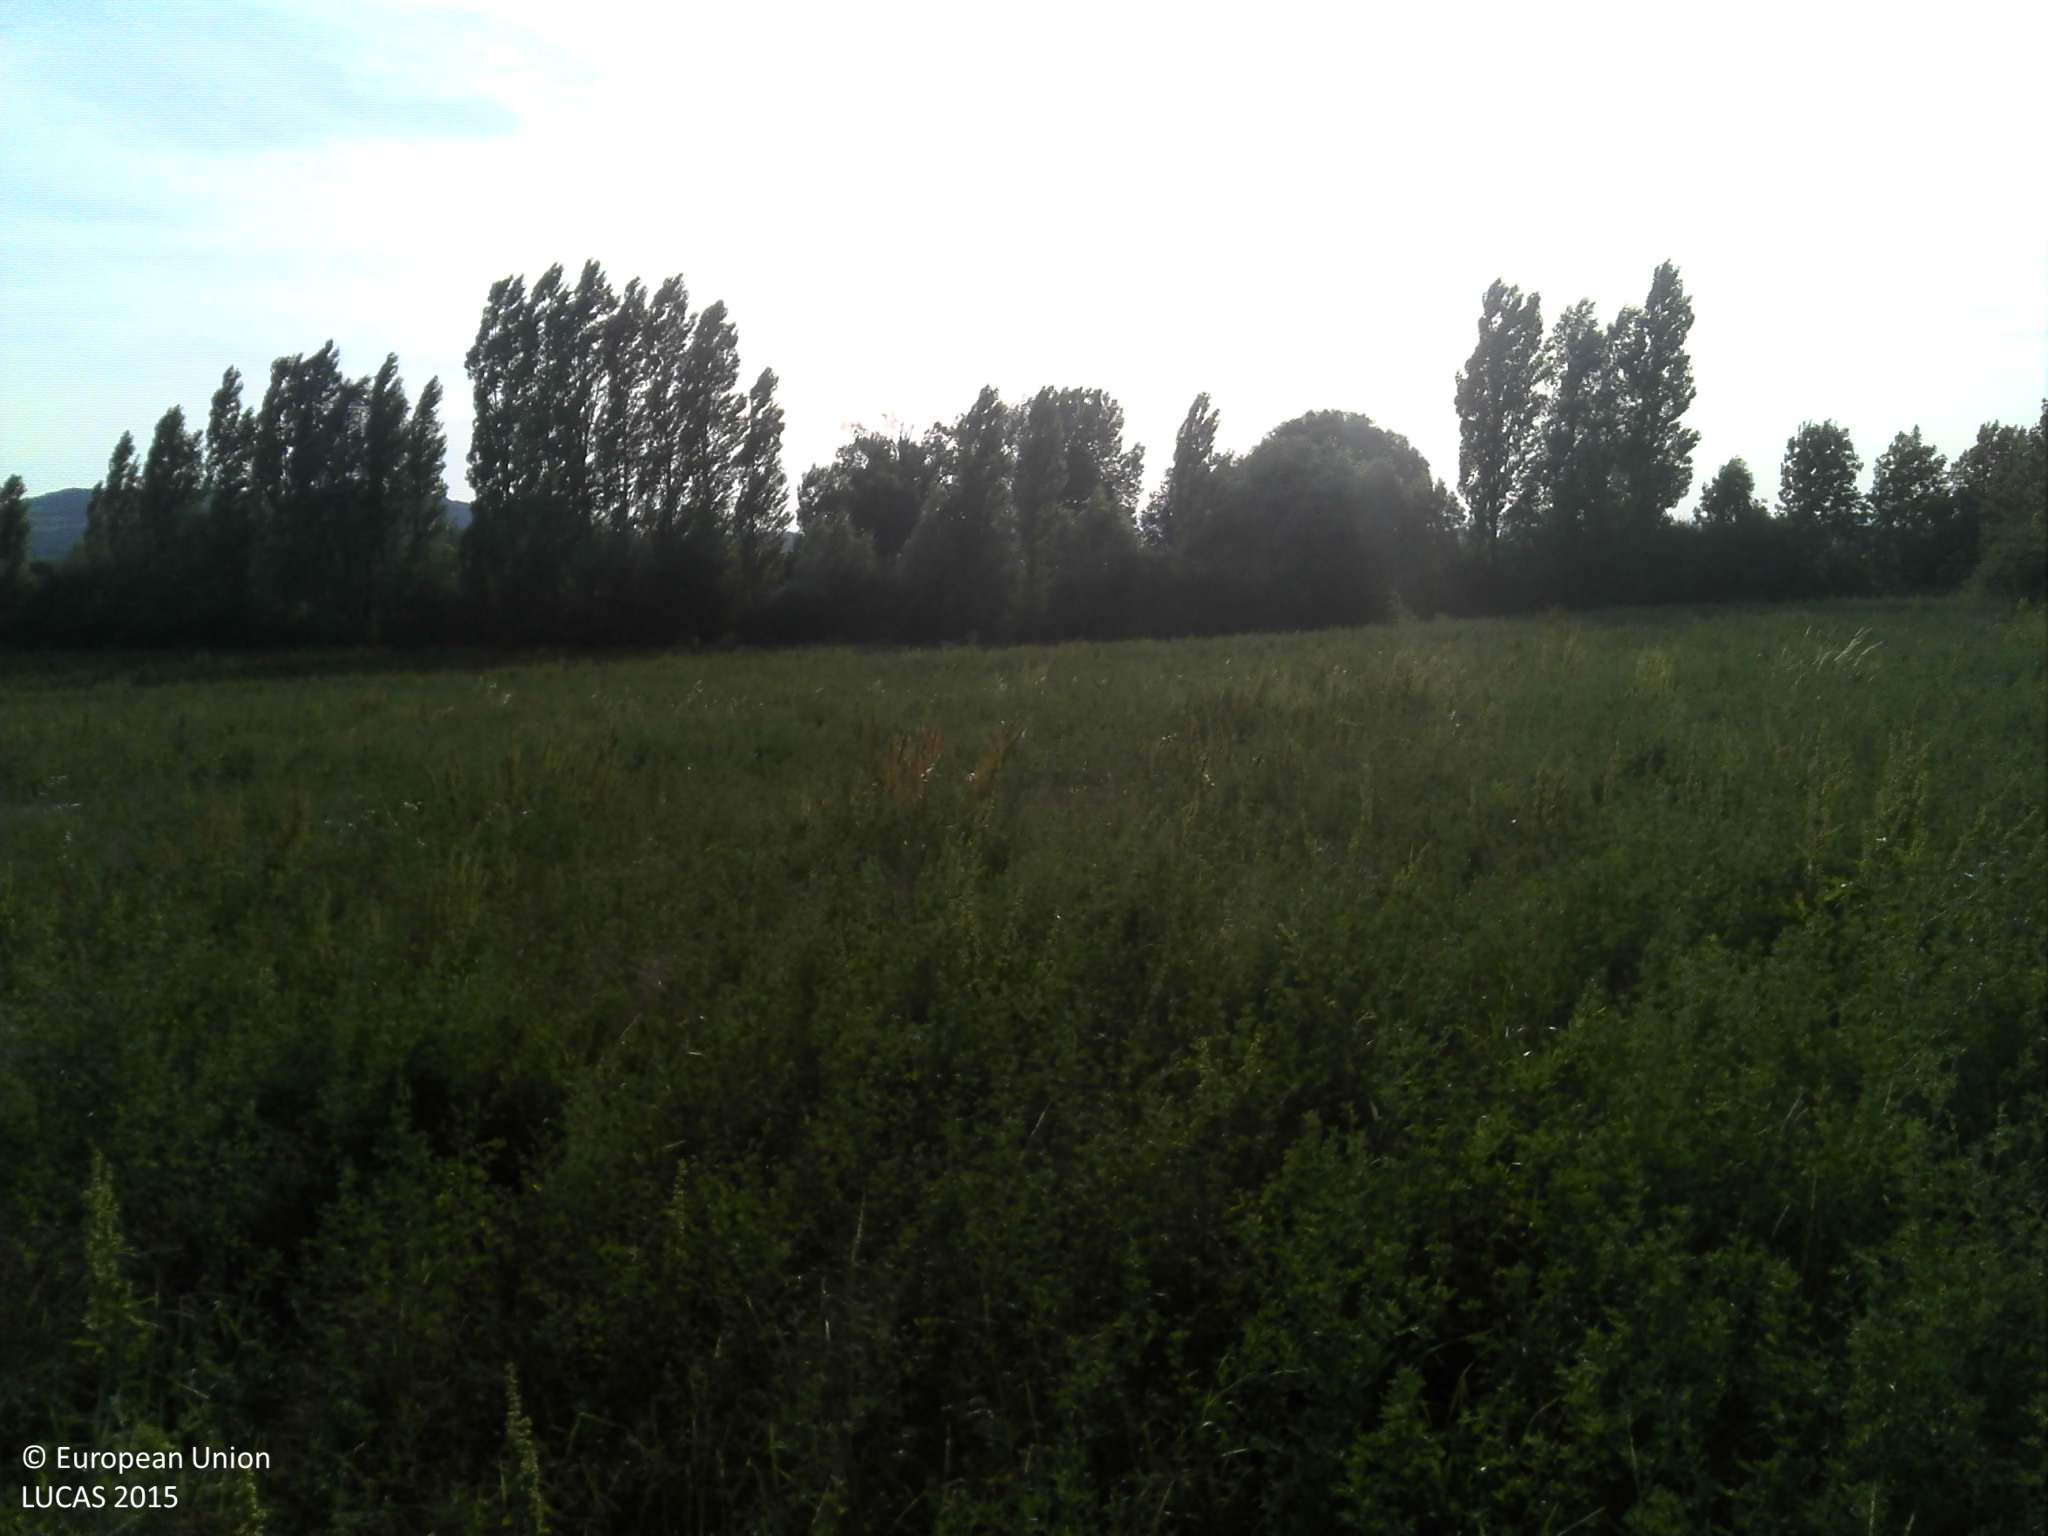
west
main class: Grassland
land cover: Spontaneously vegetated surfaces
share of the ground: > 75 %
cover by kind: herbaceous plants 100 %
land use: Agriculture (excluding fallow land and kitchen gardens)
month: July
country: FR
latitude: 45.7812
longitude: 3.3251
